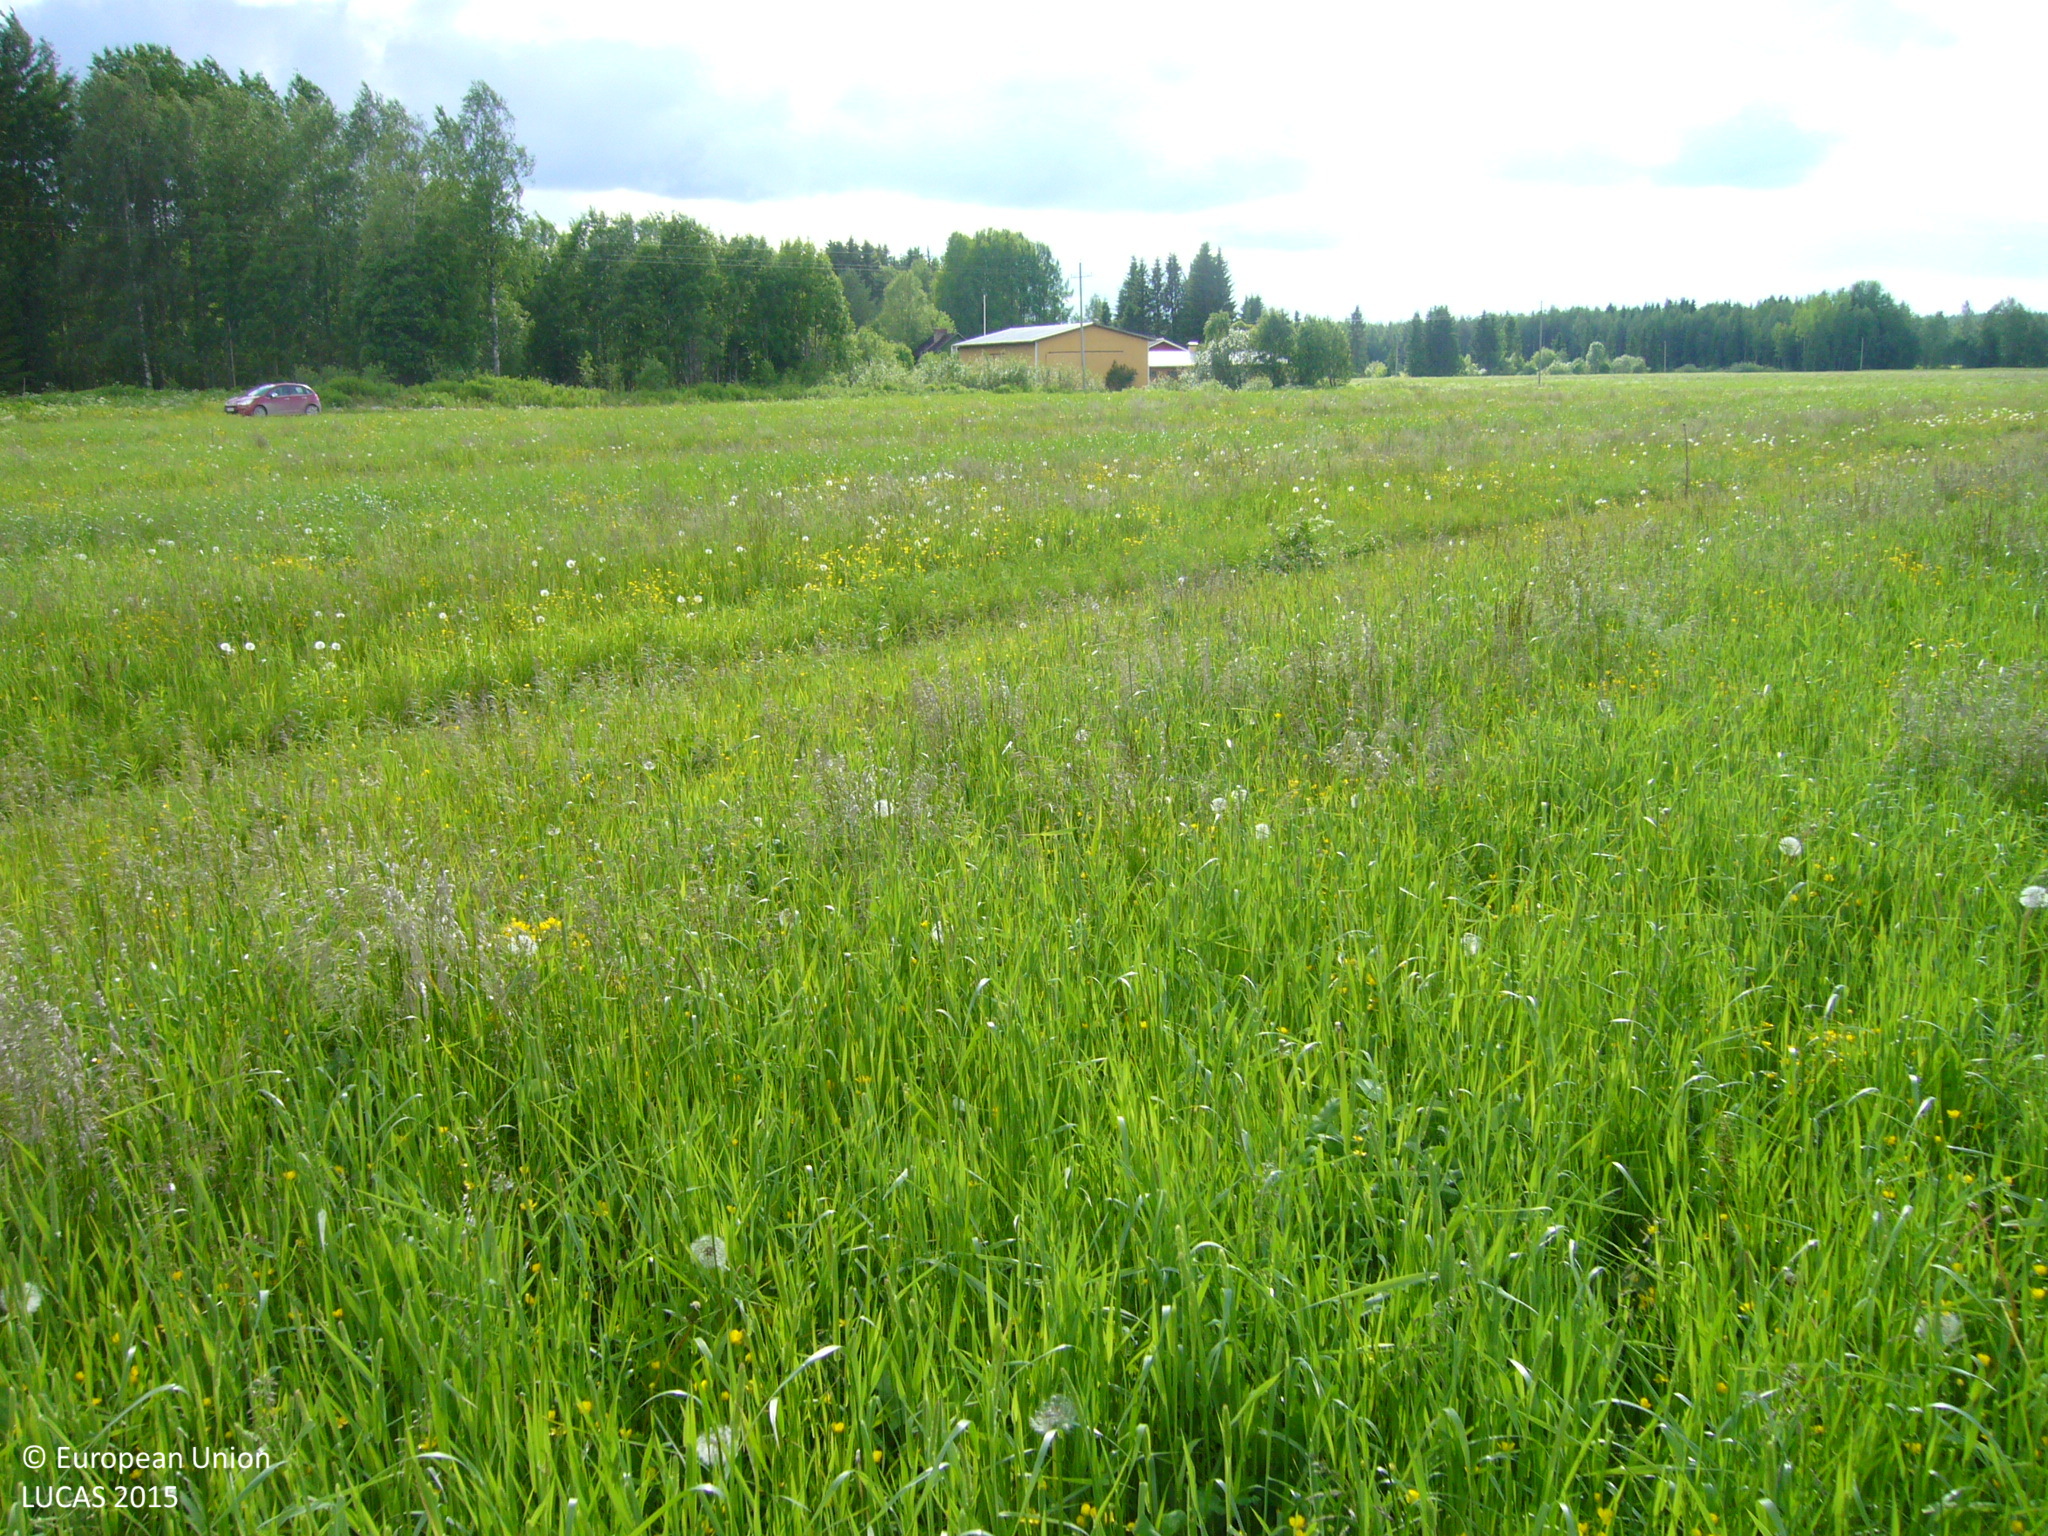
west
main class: Cropland
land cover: Temporary grasslands
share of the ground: > 75 %
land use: Agriculture (excluding fallow land and kitchen gardens)
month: June
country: FI
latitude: 63.7318
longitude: 26.3000
